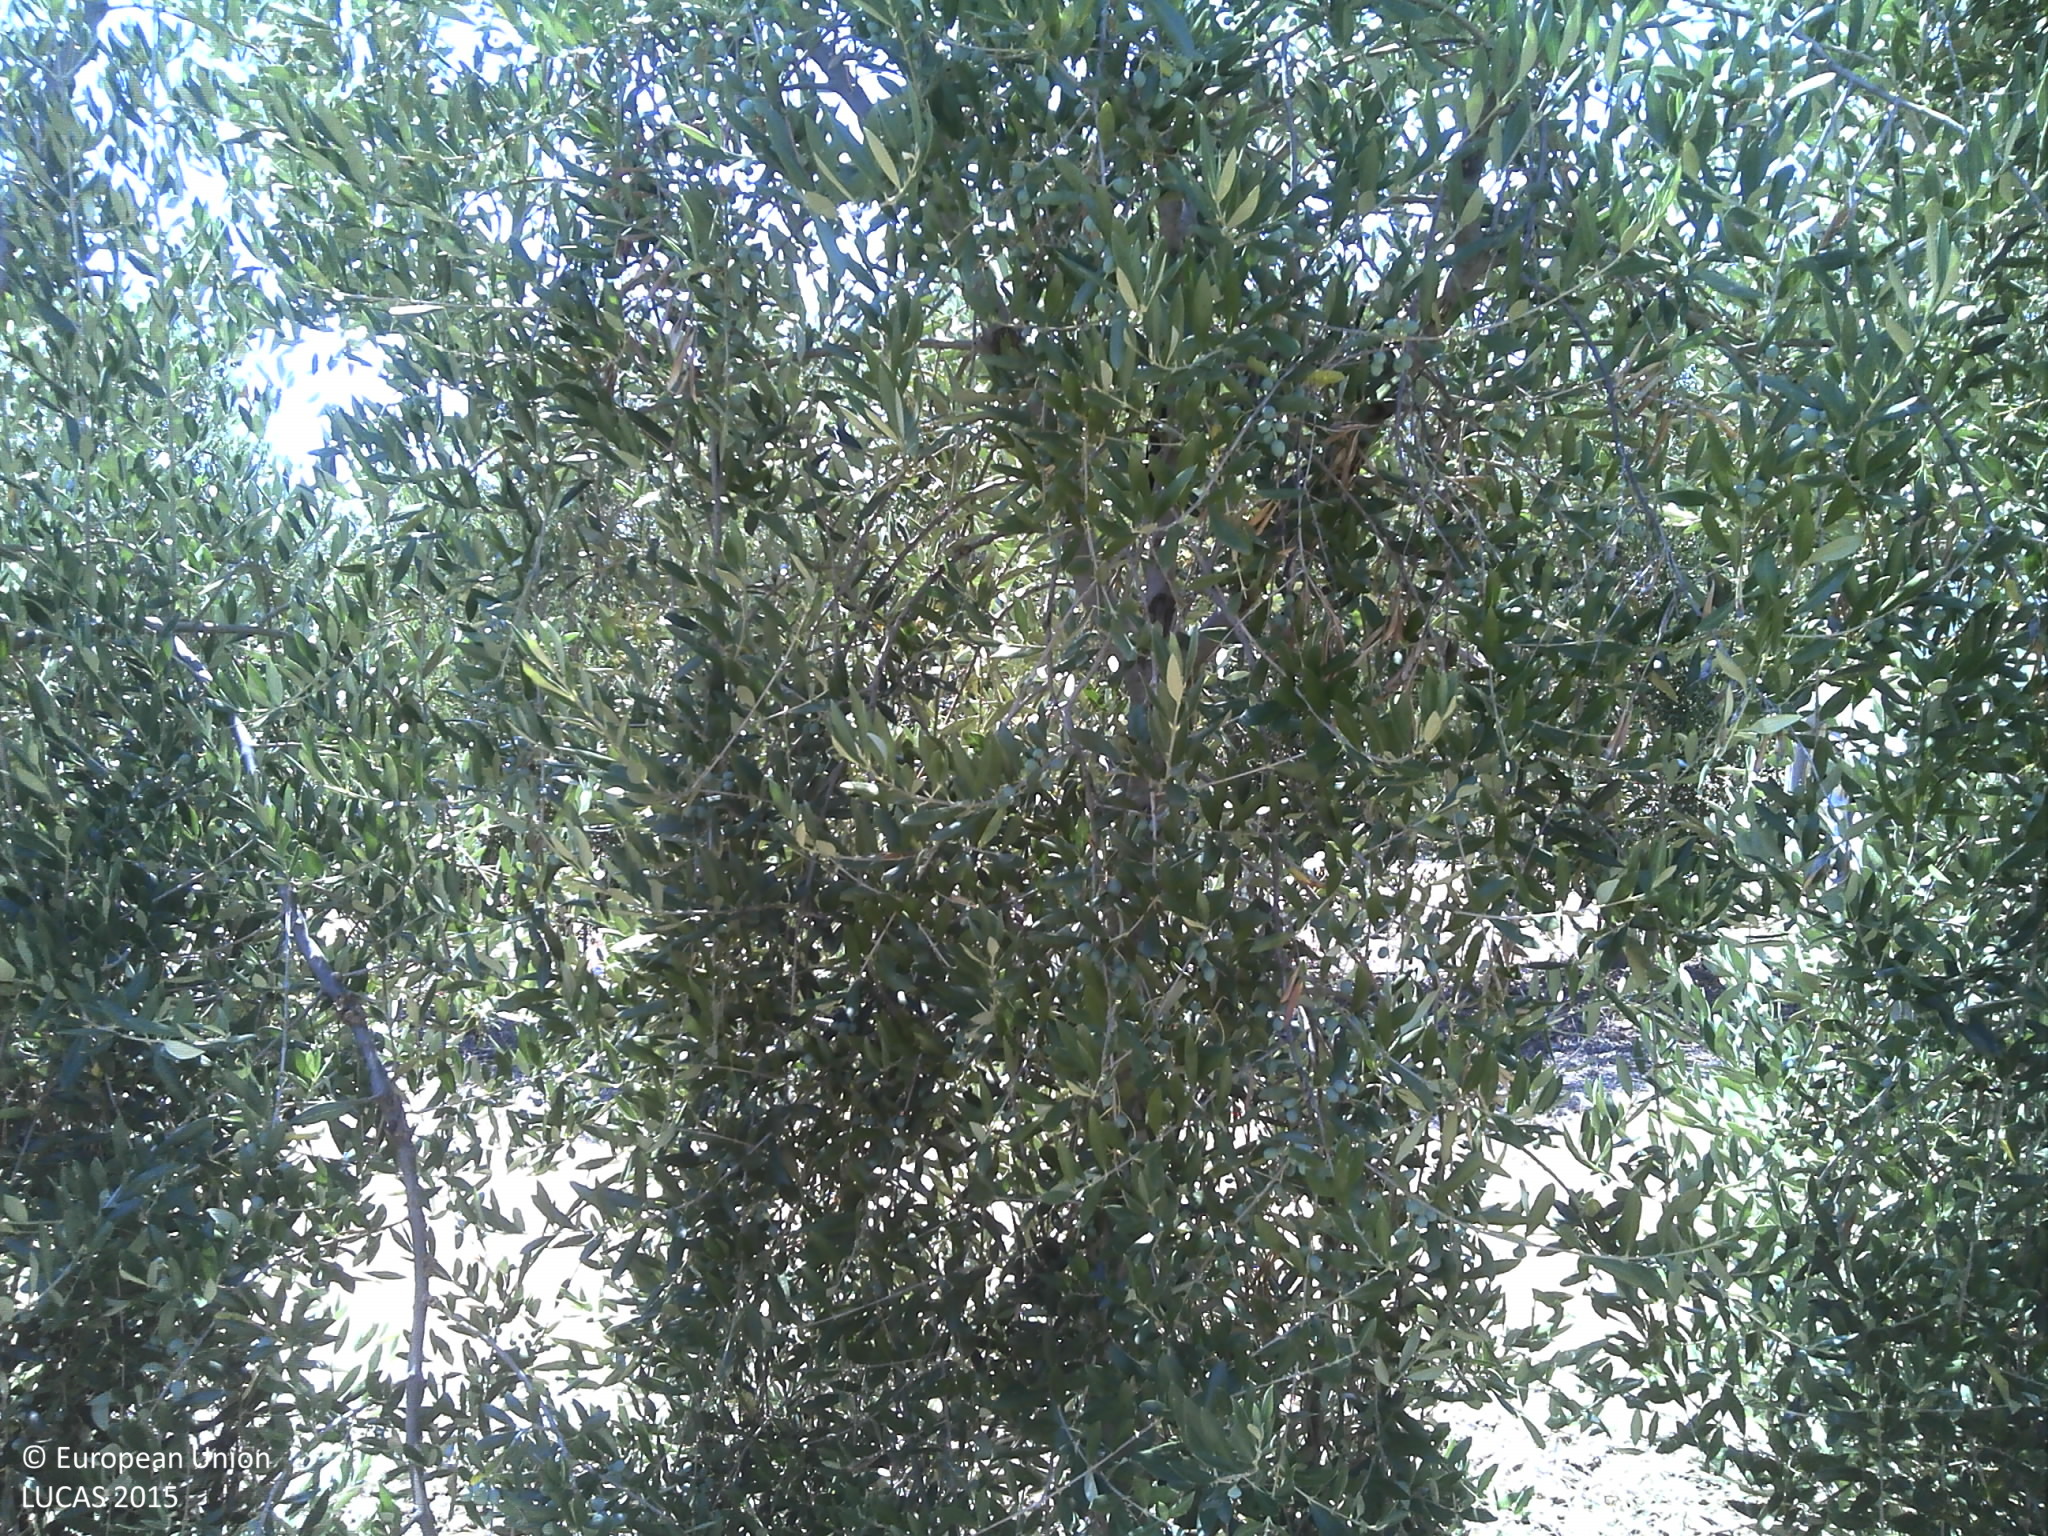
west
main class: Cropland
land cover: Olive groves
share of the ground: 25 - 50 %
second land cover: Grassland without tree/shrub cover
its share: 25 - 50 %
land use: Agriculture (excluding fallow land and kitchen gardens)
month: July
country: PT
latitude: 39.0026
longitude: -7.5561
